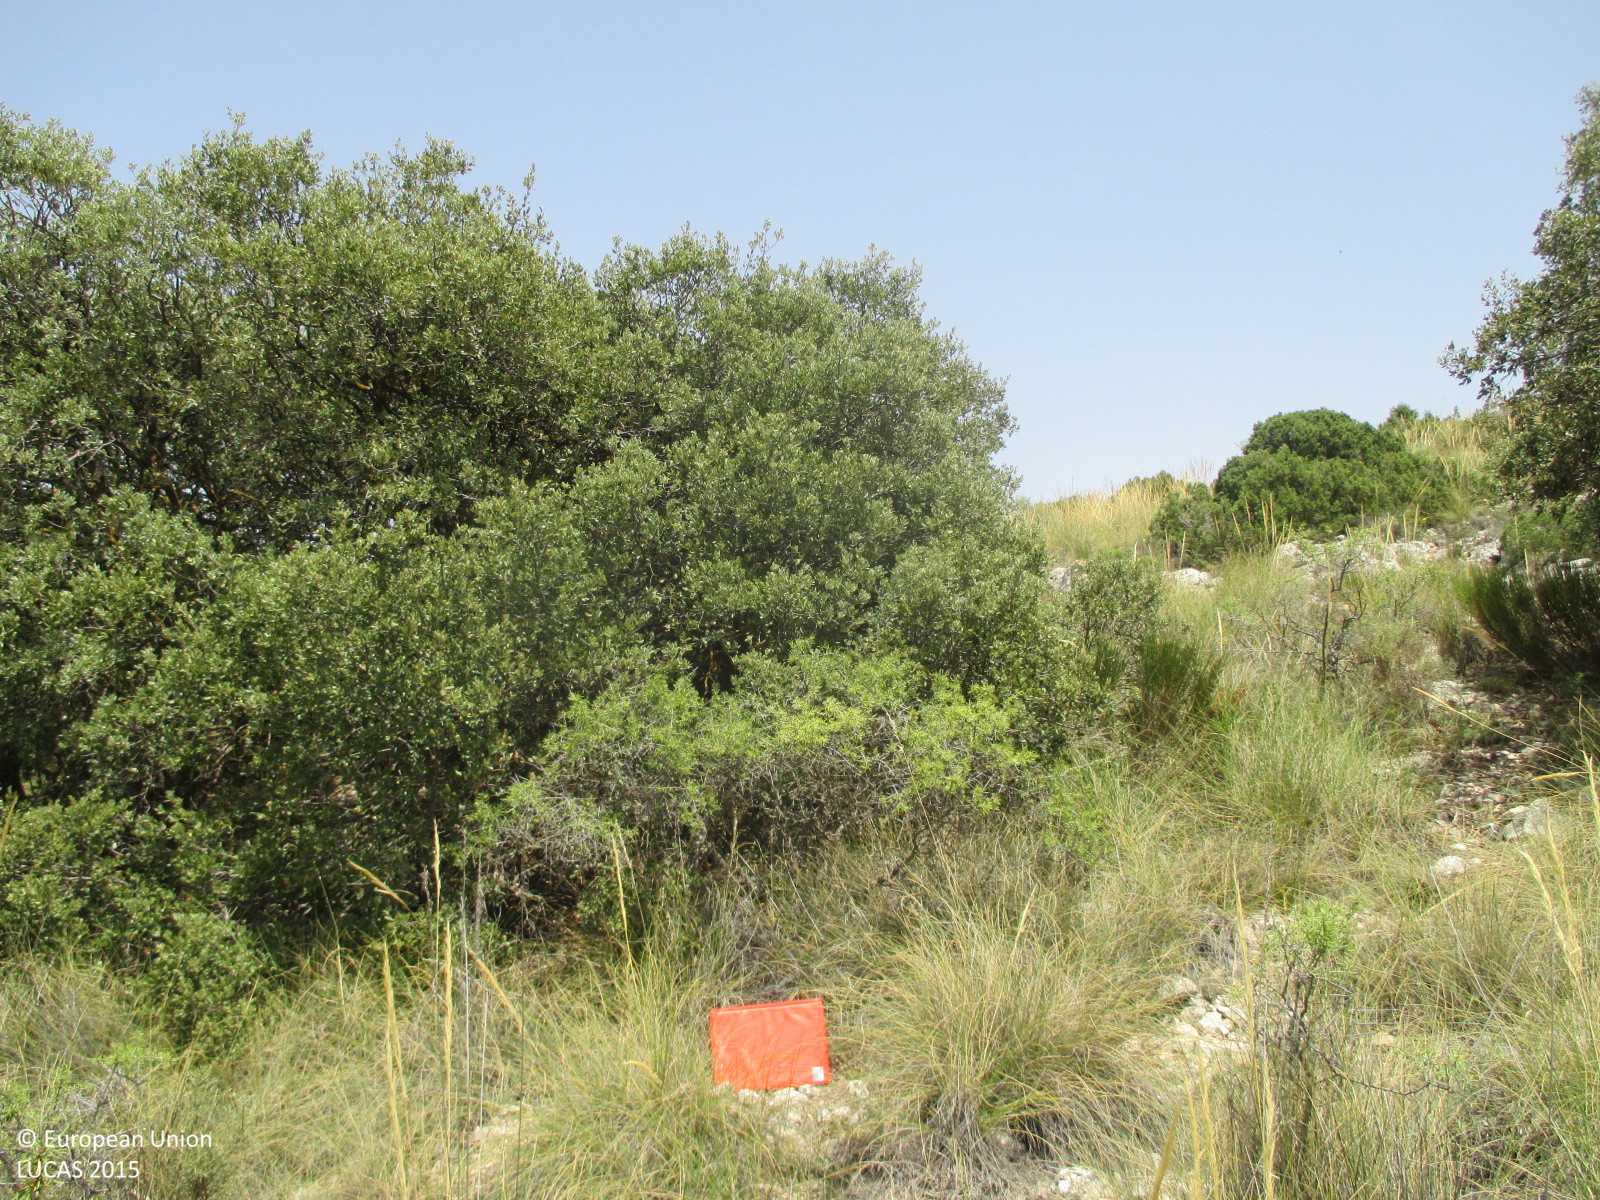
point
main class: Woodland
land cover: Broadleaved woodland
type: broadleaved evergreen forest
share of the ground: 50 - 75 %
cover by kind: broadleaved forest trees 50 %, herbaceous plants 40 %, shrubs 10 %
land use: Semi-natural and natural areas not in use
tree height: < 5 m
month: July
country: ES
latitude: 37.9247
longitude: -2.3791
